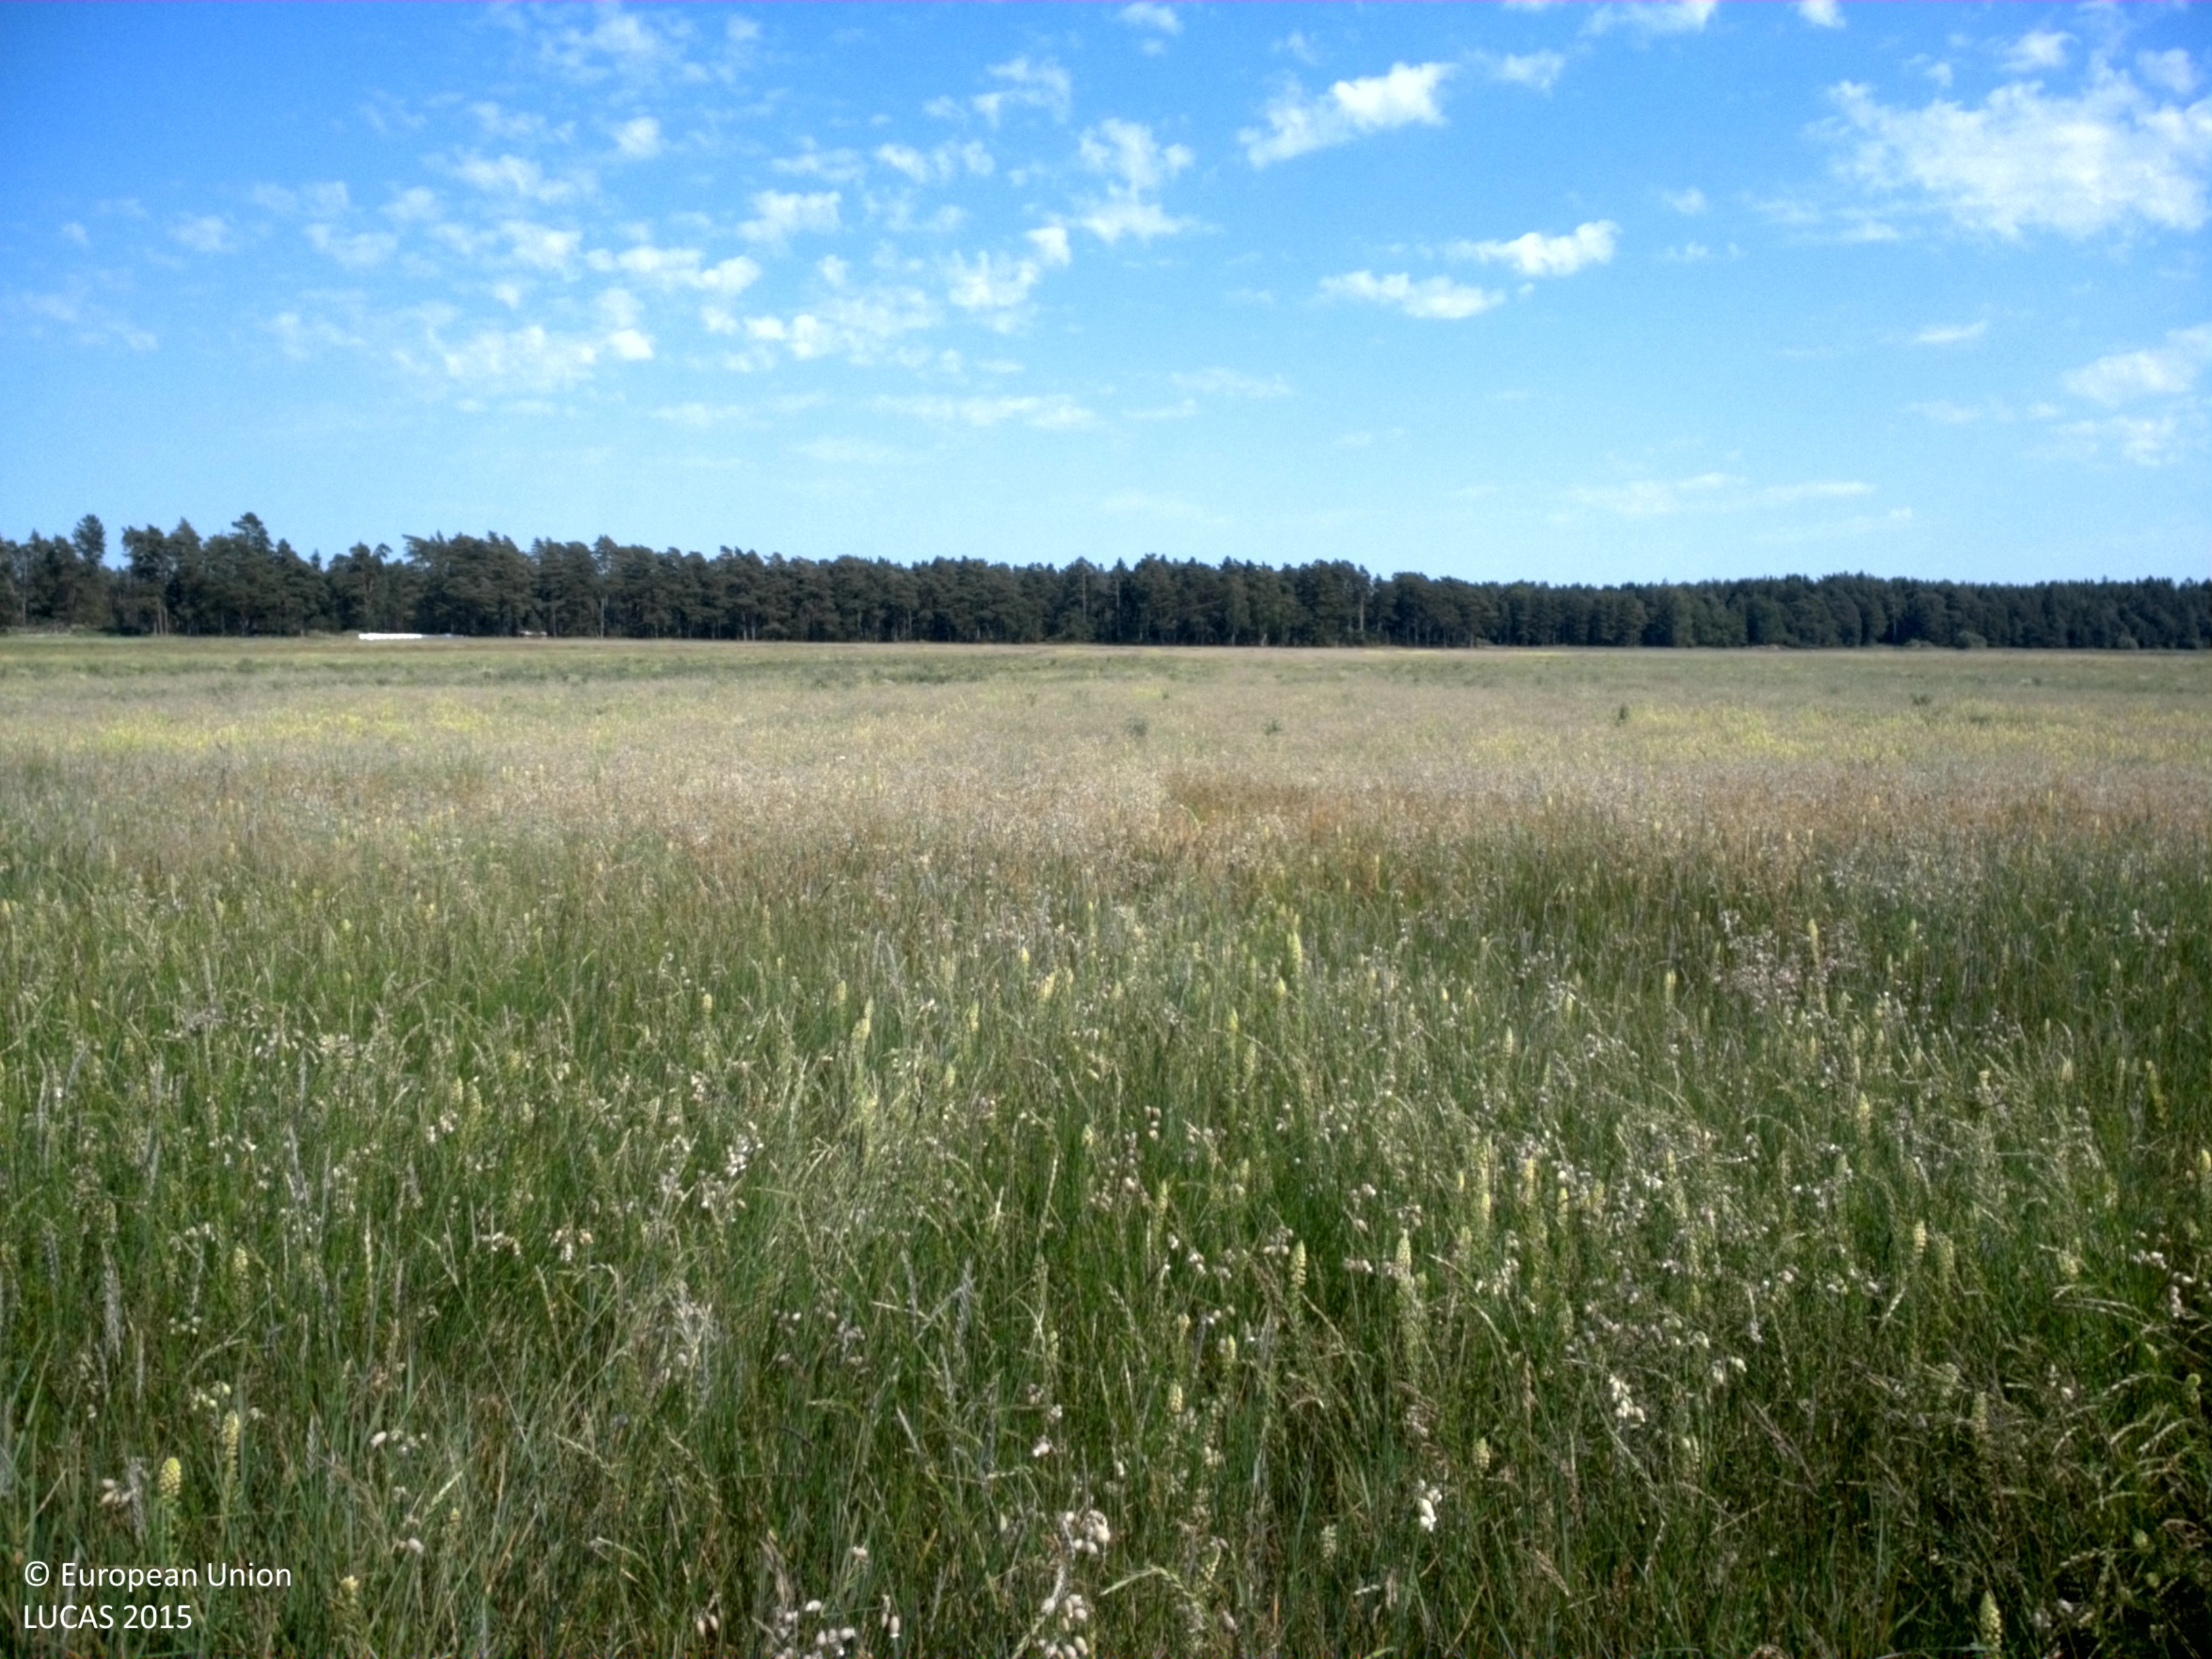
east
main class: Grassland
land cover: Spontaneously vegetated surfaces
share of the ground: > 75 %
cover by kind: herbaceous plants 95 %, shrubs 5 %
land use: Agriculture (excluding fallow land and kitchen gardens)
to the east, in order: Spontaneously vegetated surfaces; Ditches and canals; Spontaneously vegetated surfaces; Temporary grasslands
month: July
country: SE
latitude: 57.7293
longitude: 18.5556
